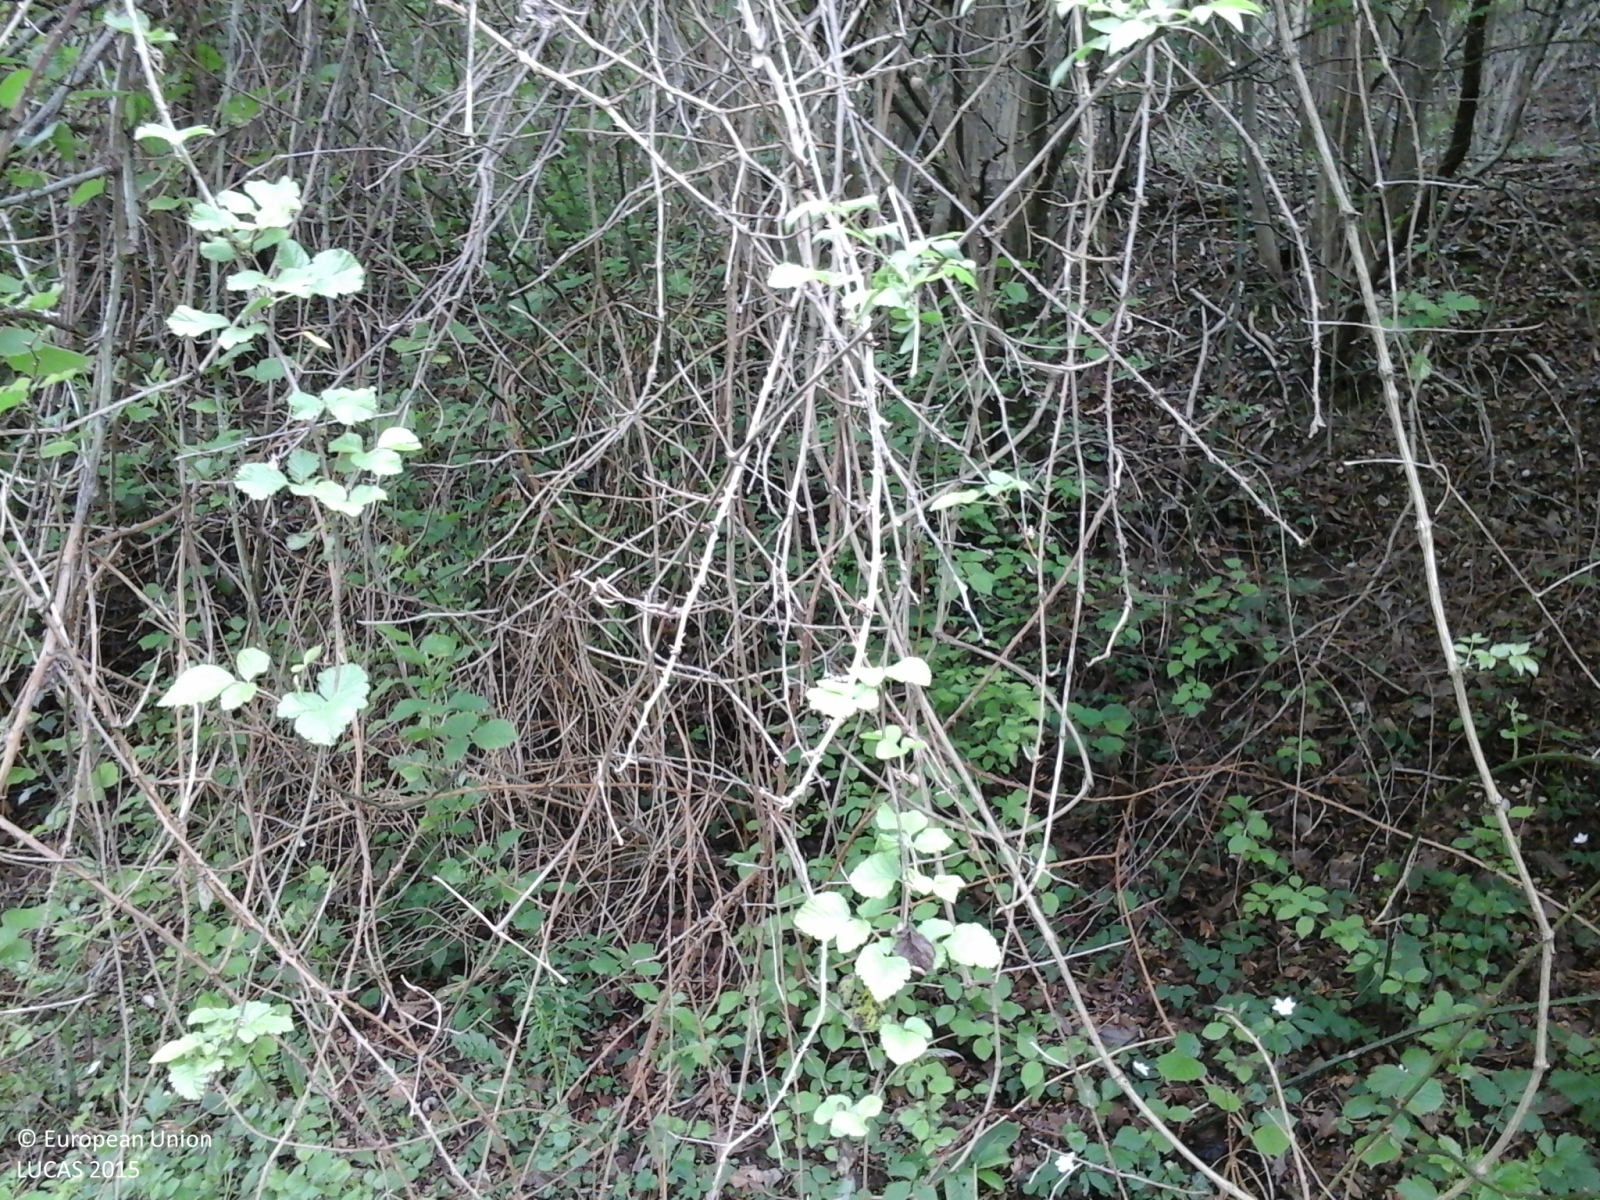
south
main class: Woodland
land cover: Broadleaved woodland
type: thermophilous deciduous forest
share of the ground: > 75 %
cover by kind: broadleaved forest trees 100 %
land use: Forestry
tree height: > 5 m
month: April
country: IT
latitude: 45.9686
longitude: 12.1780
